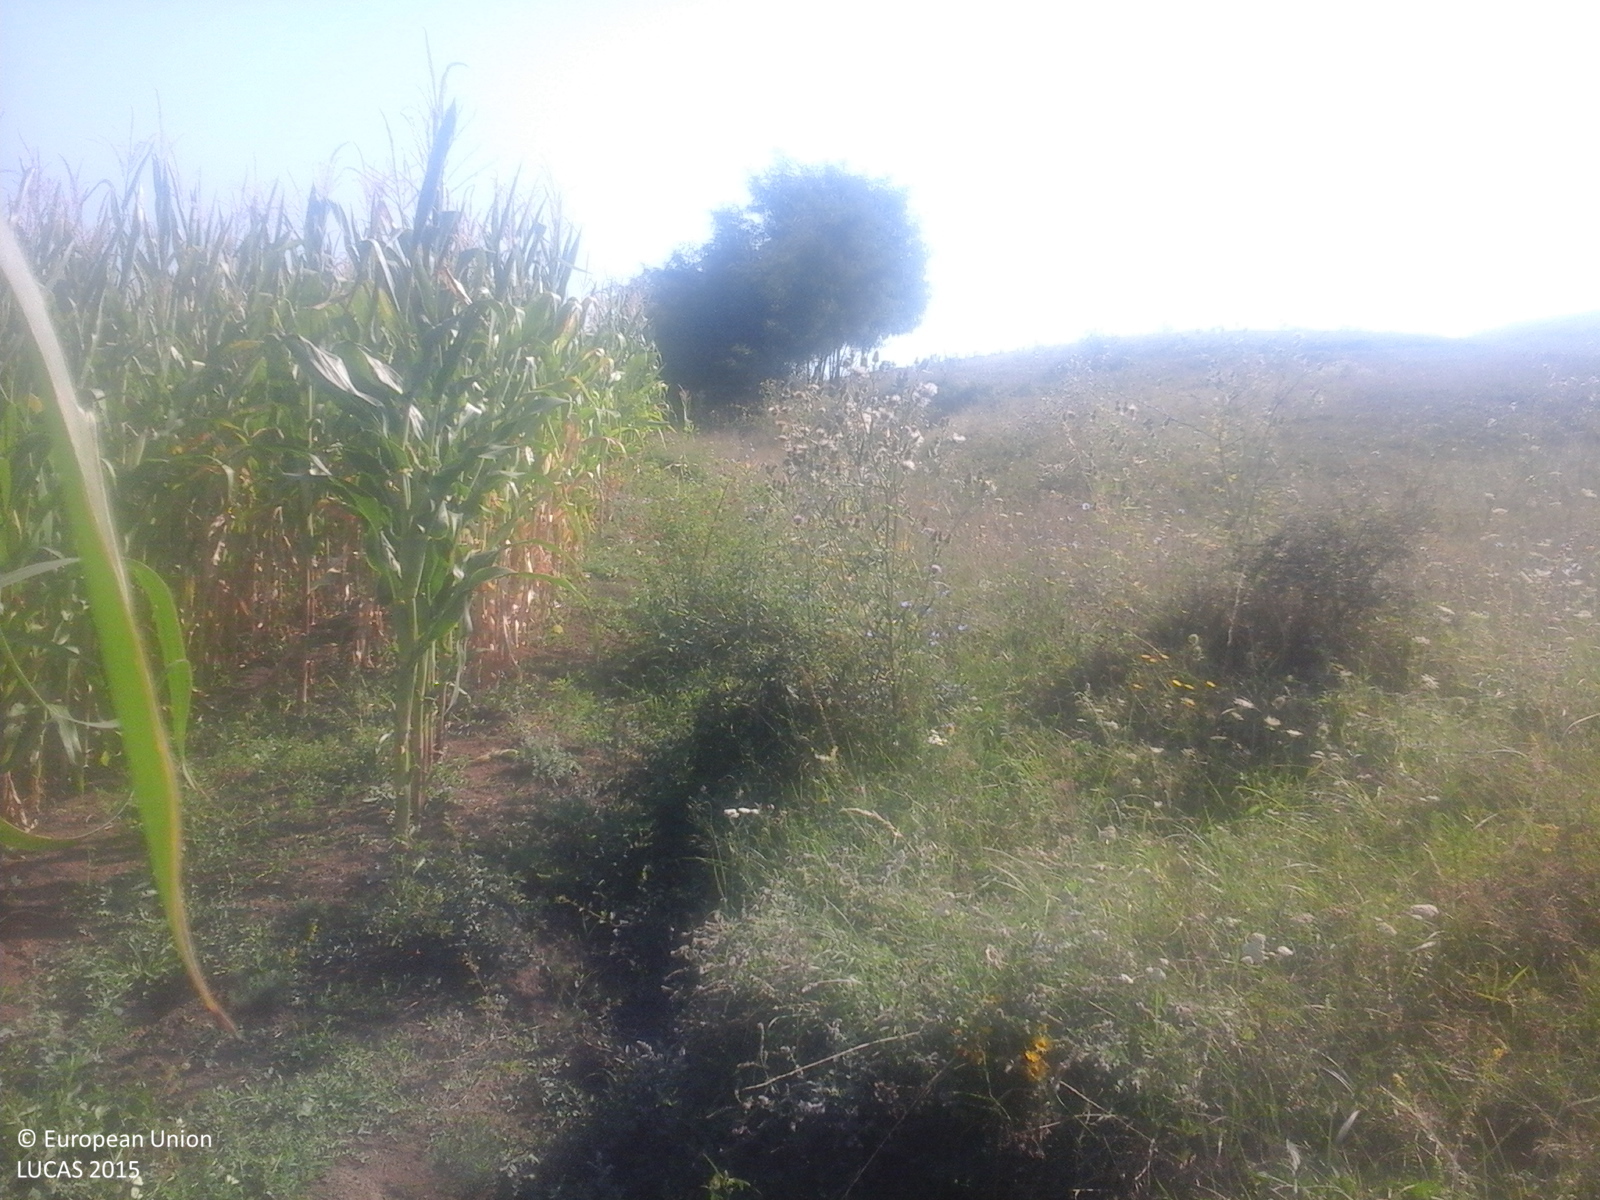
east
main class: Cropland
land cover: Maize
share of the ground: > 75 %
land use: Agriculture (excluding fallow land and kitchen gardens)
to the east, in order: Maize; Grassland without tree/shrub cover; Grassland with sparse tree/shrub cover; Shrubland with sparse tree cover
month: September
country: RO
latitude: 46.8451
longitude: 24.4472
